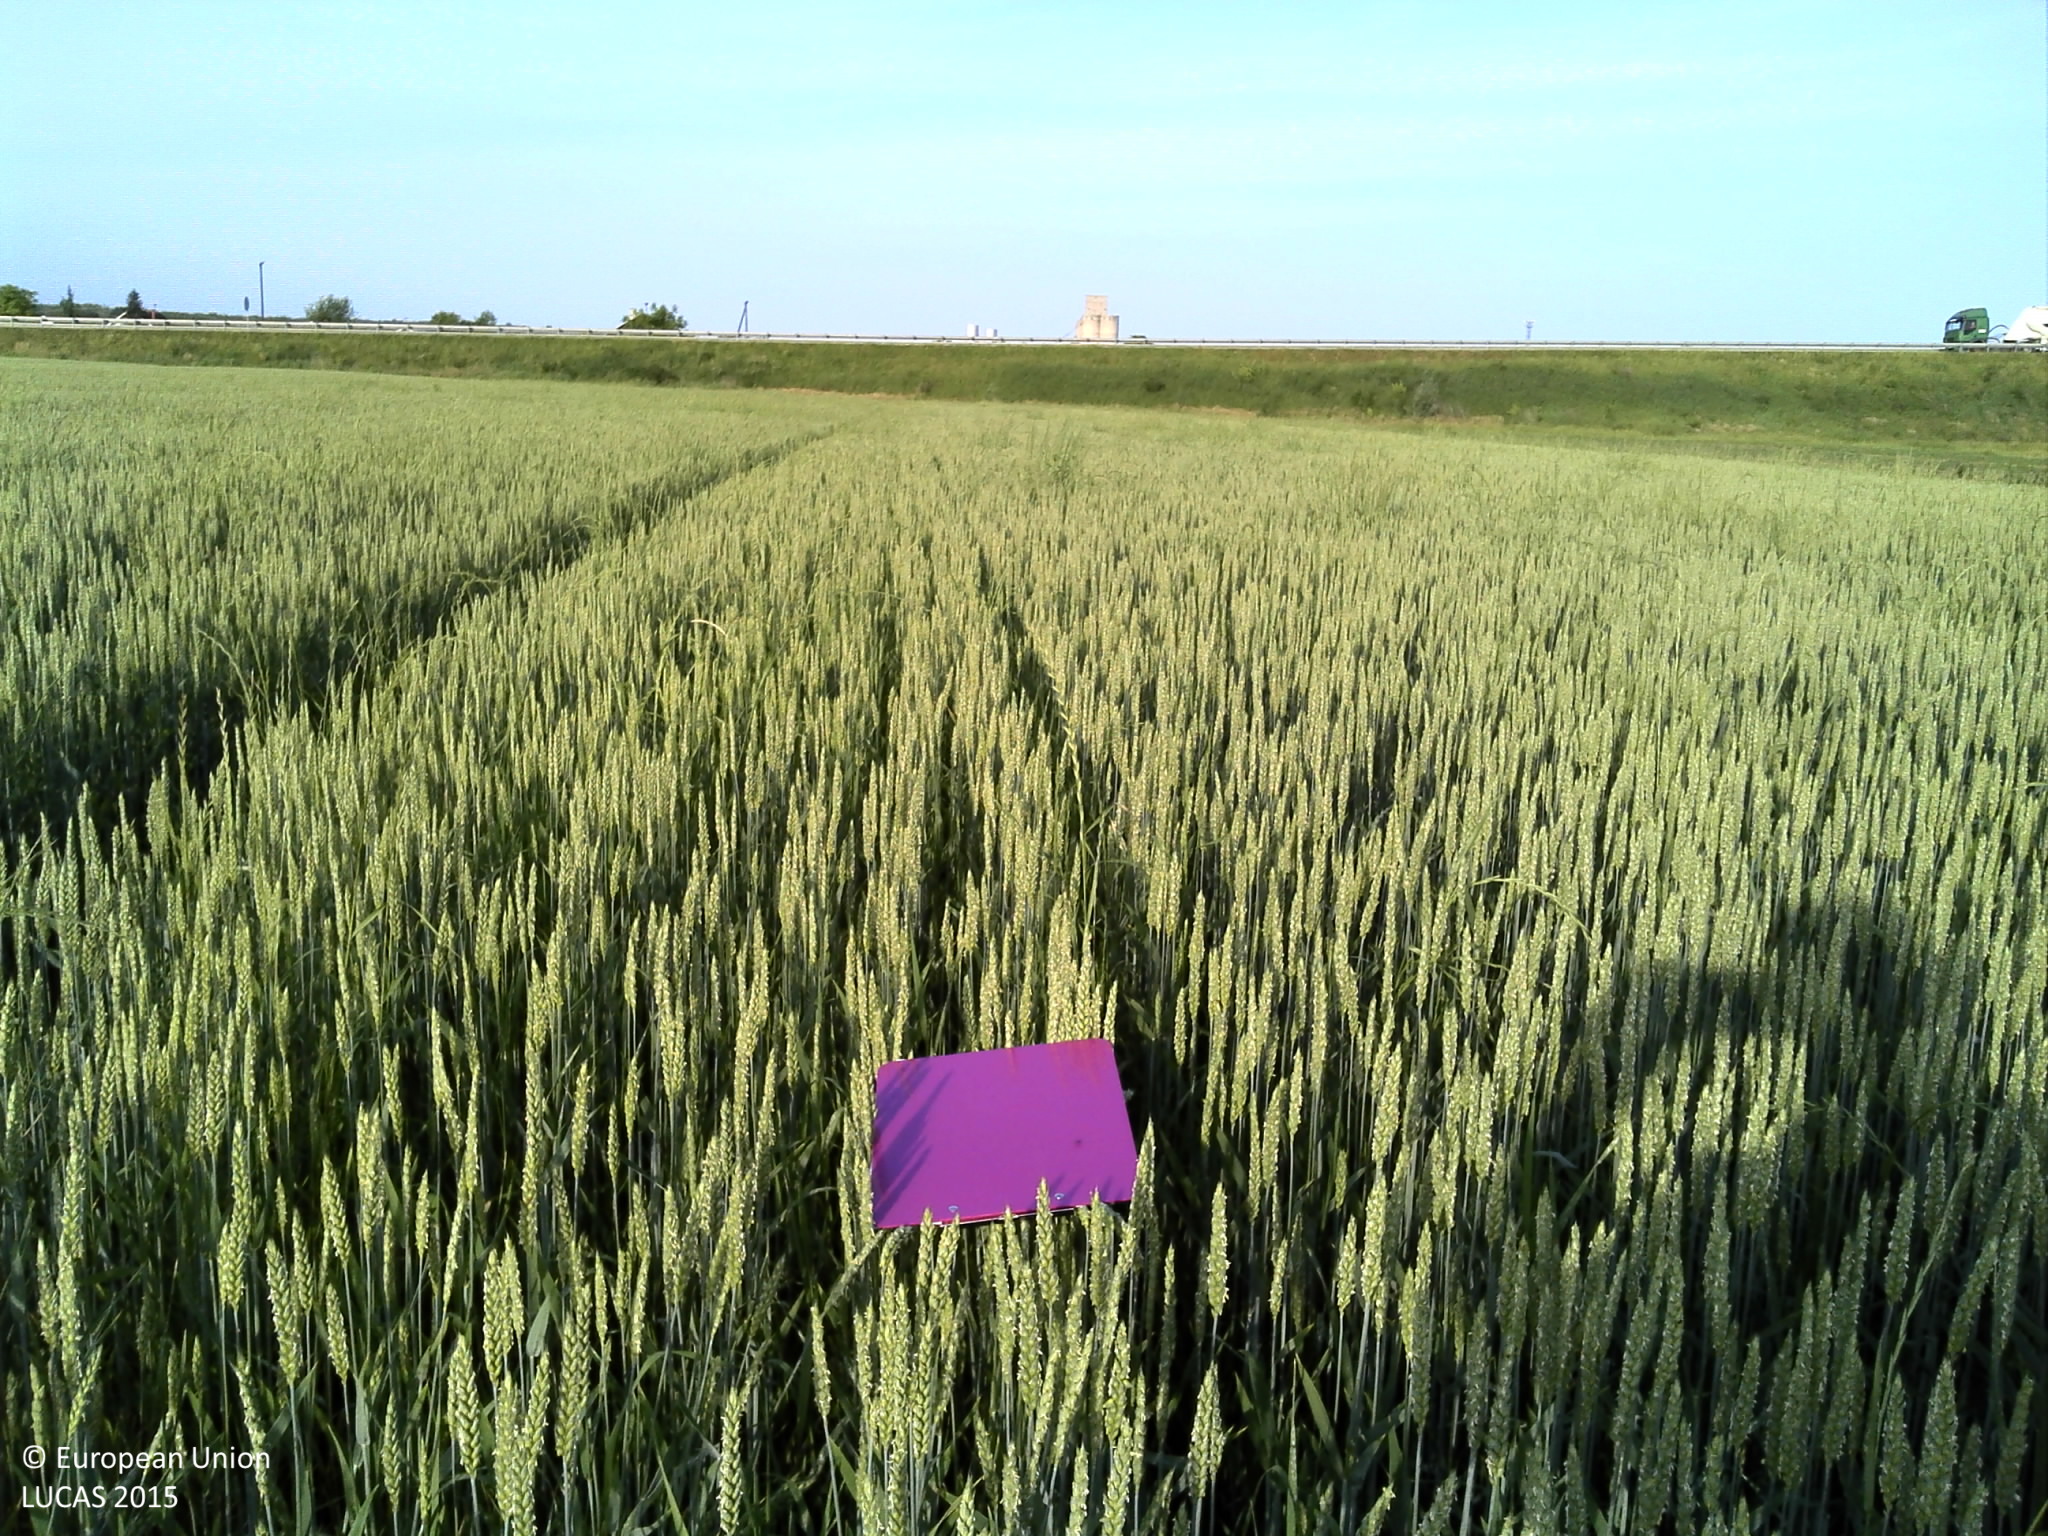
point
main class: Cropland
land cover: Common wheat
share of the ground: > 75 %
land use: Agriculture (excluding fallow land and kitchen gardens)
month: May
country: HR
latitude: 45.4983
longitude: 18.1306
